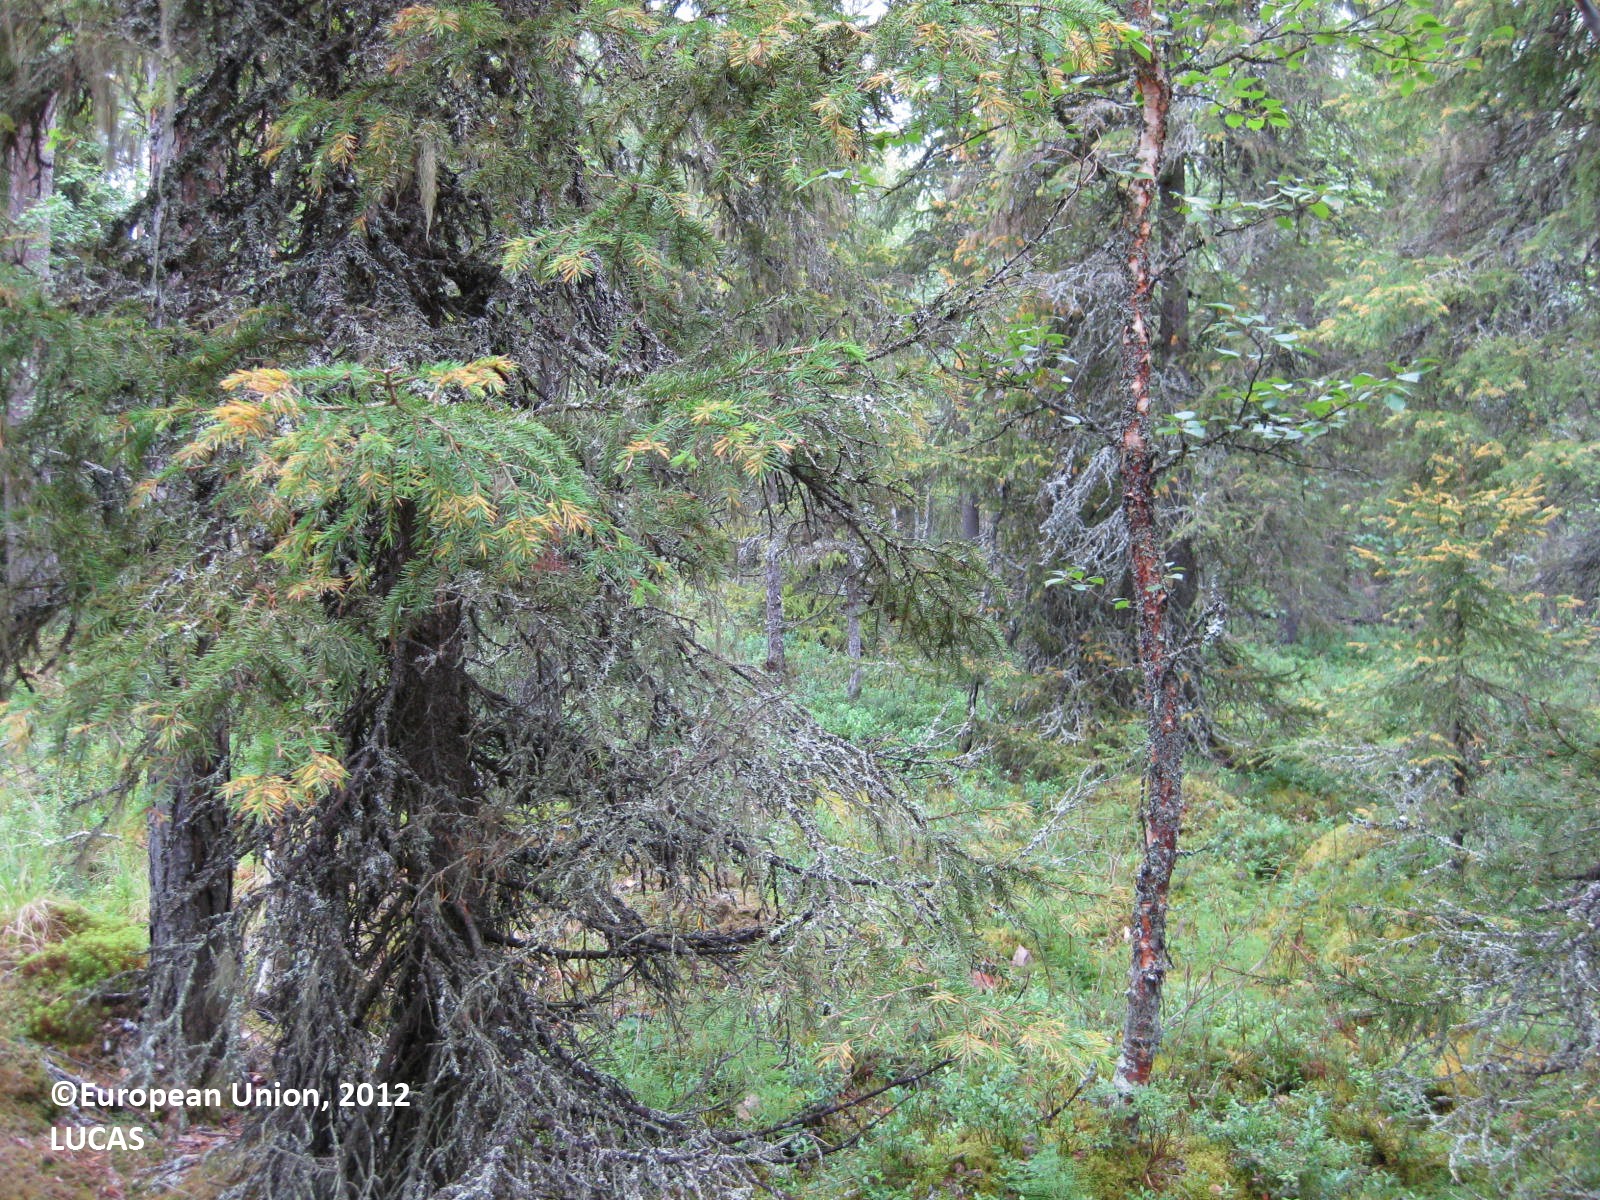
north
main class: Woodland
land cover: Spruce dominated coniferous woodland
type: boreal forest
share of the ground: > 75 %
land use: Forestry
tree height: > 5 m
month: August
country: FI
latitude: 65.8845
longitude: 28.2427
